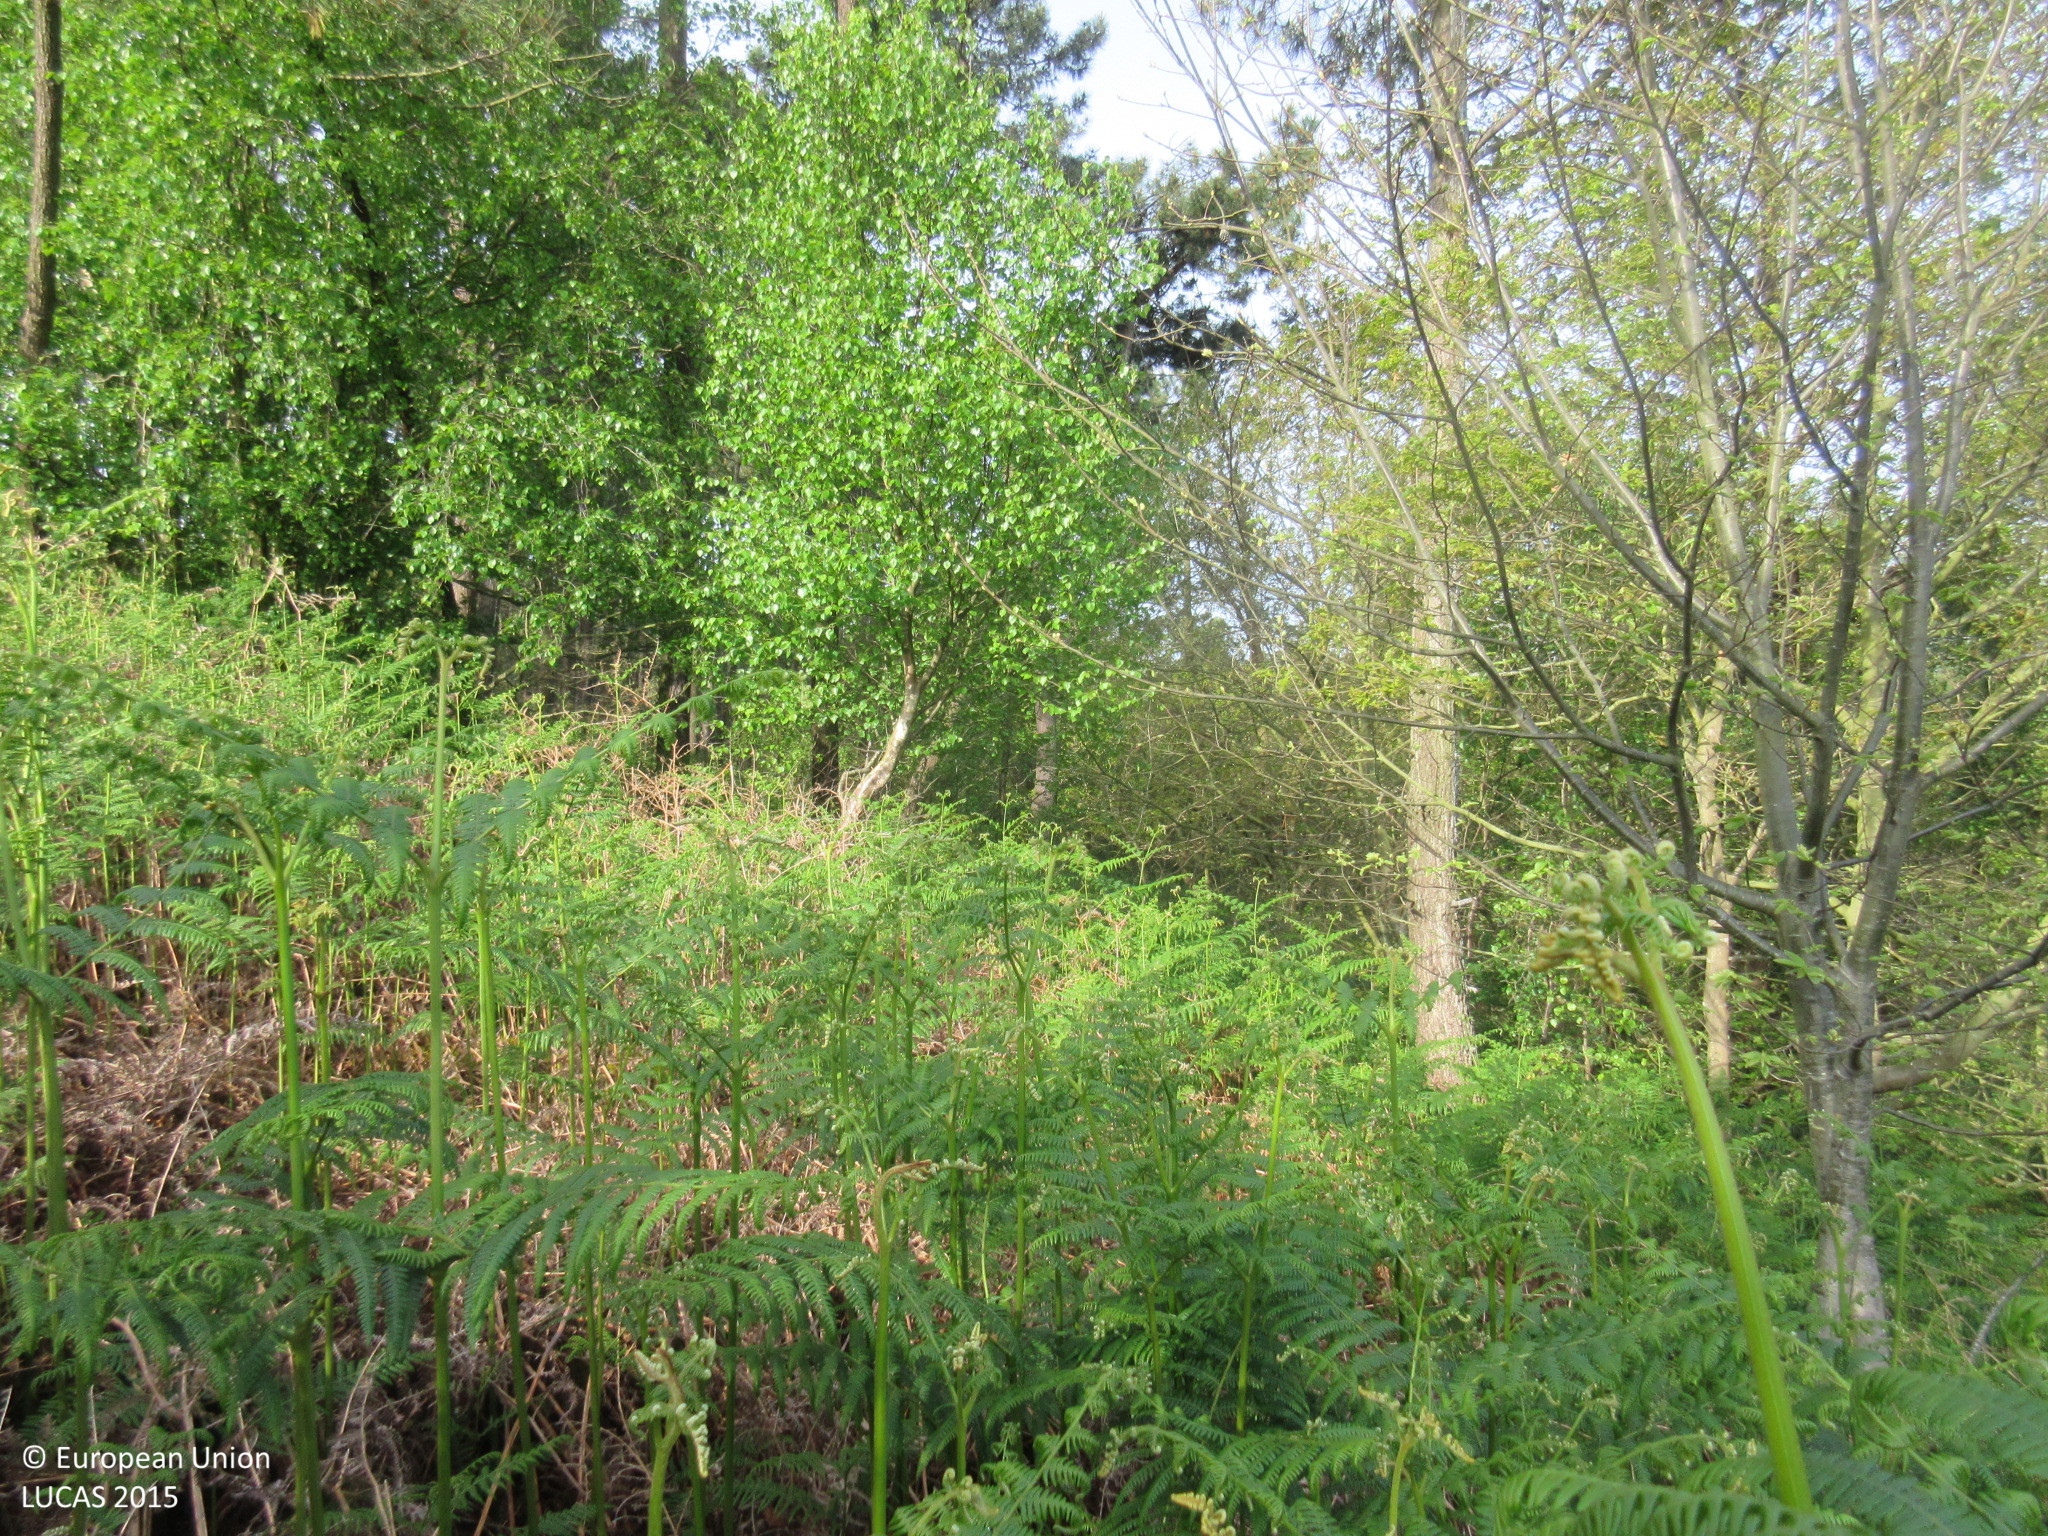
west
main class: Shrubland
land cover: Shrubland without tree cover
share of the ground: > 75 %
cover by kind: shrubs 100 %
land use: Semi-natural and natural areas not in use
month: April
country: ES
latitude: 43.5189
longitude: -6.6998
